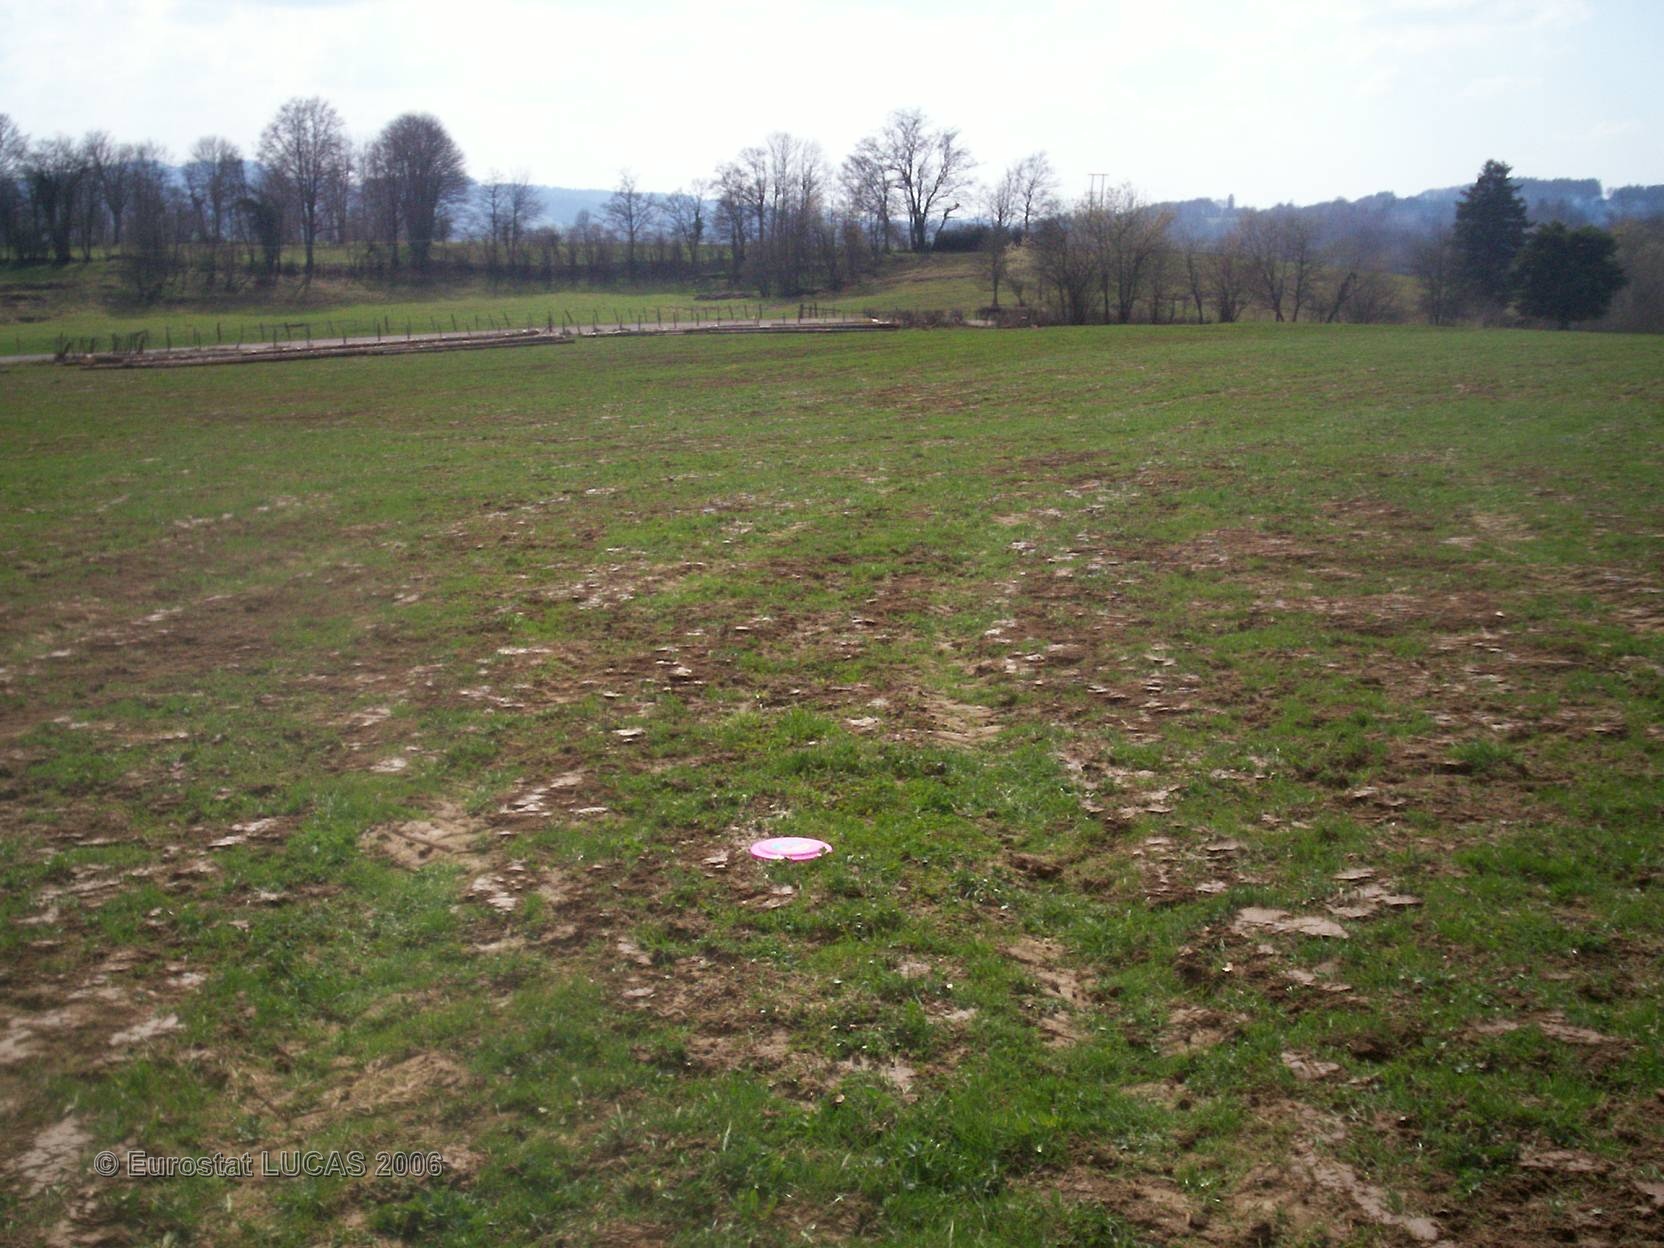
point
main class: Grassland
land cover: Grassland without tree/shrub cover
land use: Agriculture (excluding fallow land and kitchen gardens)
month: April
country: FR
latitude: 47.3160
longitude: 6.9195
